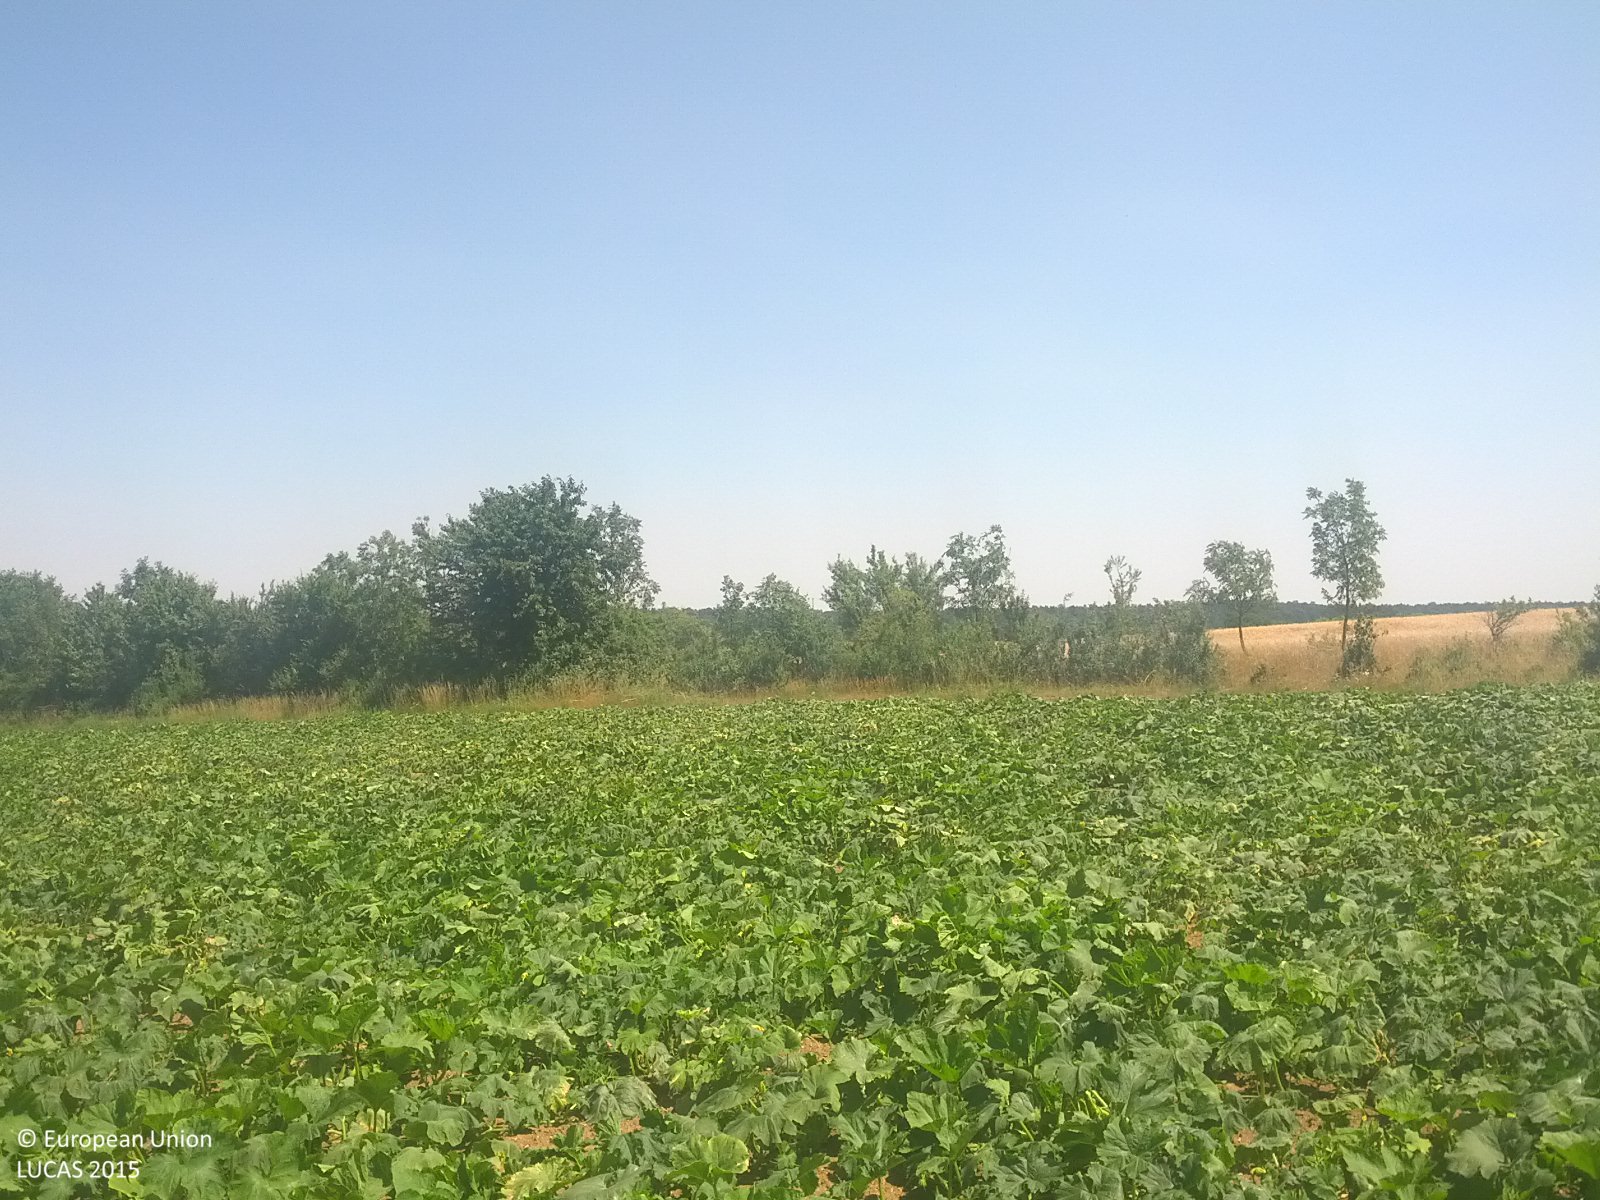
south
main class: Cropland
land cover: Other fresh vegetables
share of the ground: > 75 %
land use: Agriculture (excluding fallow land and kitchen gardens)
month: July
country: AT
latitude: 48.5327
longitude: 16.5744
